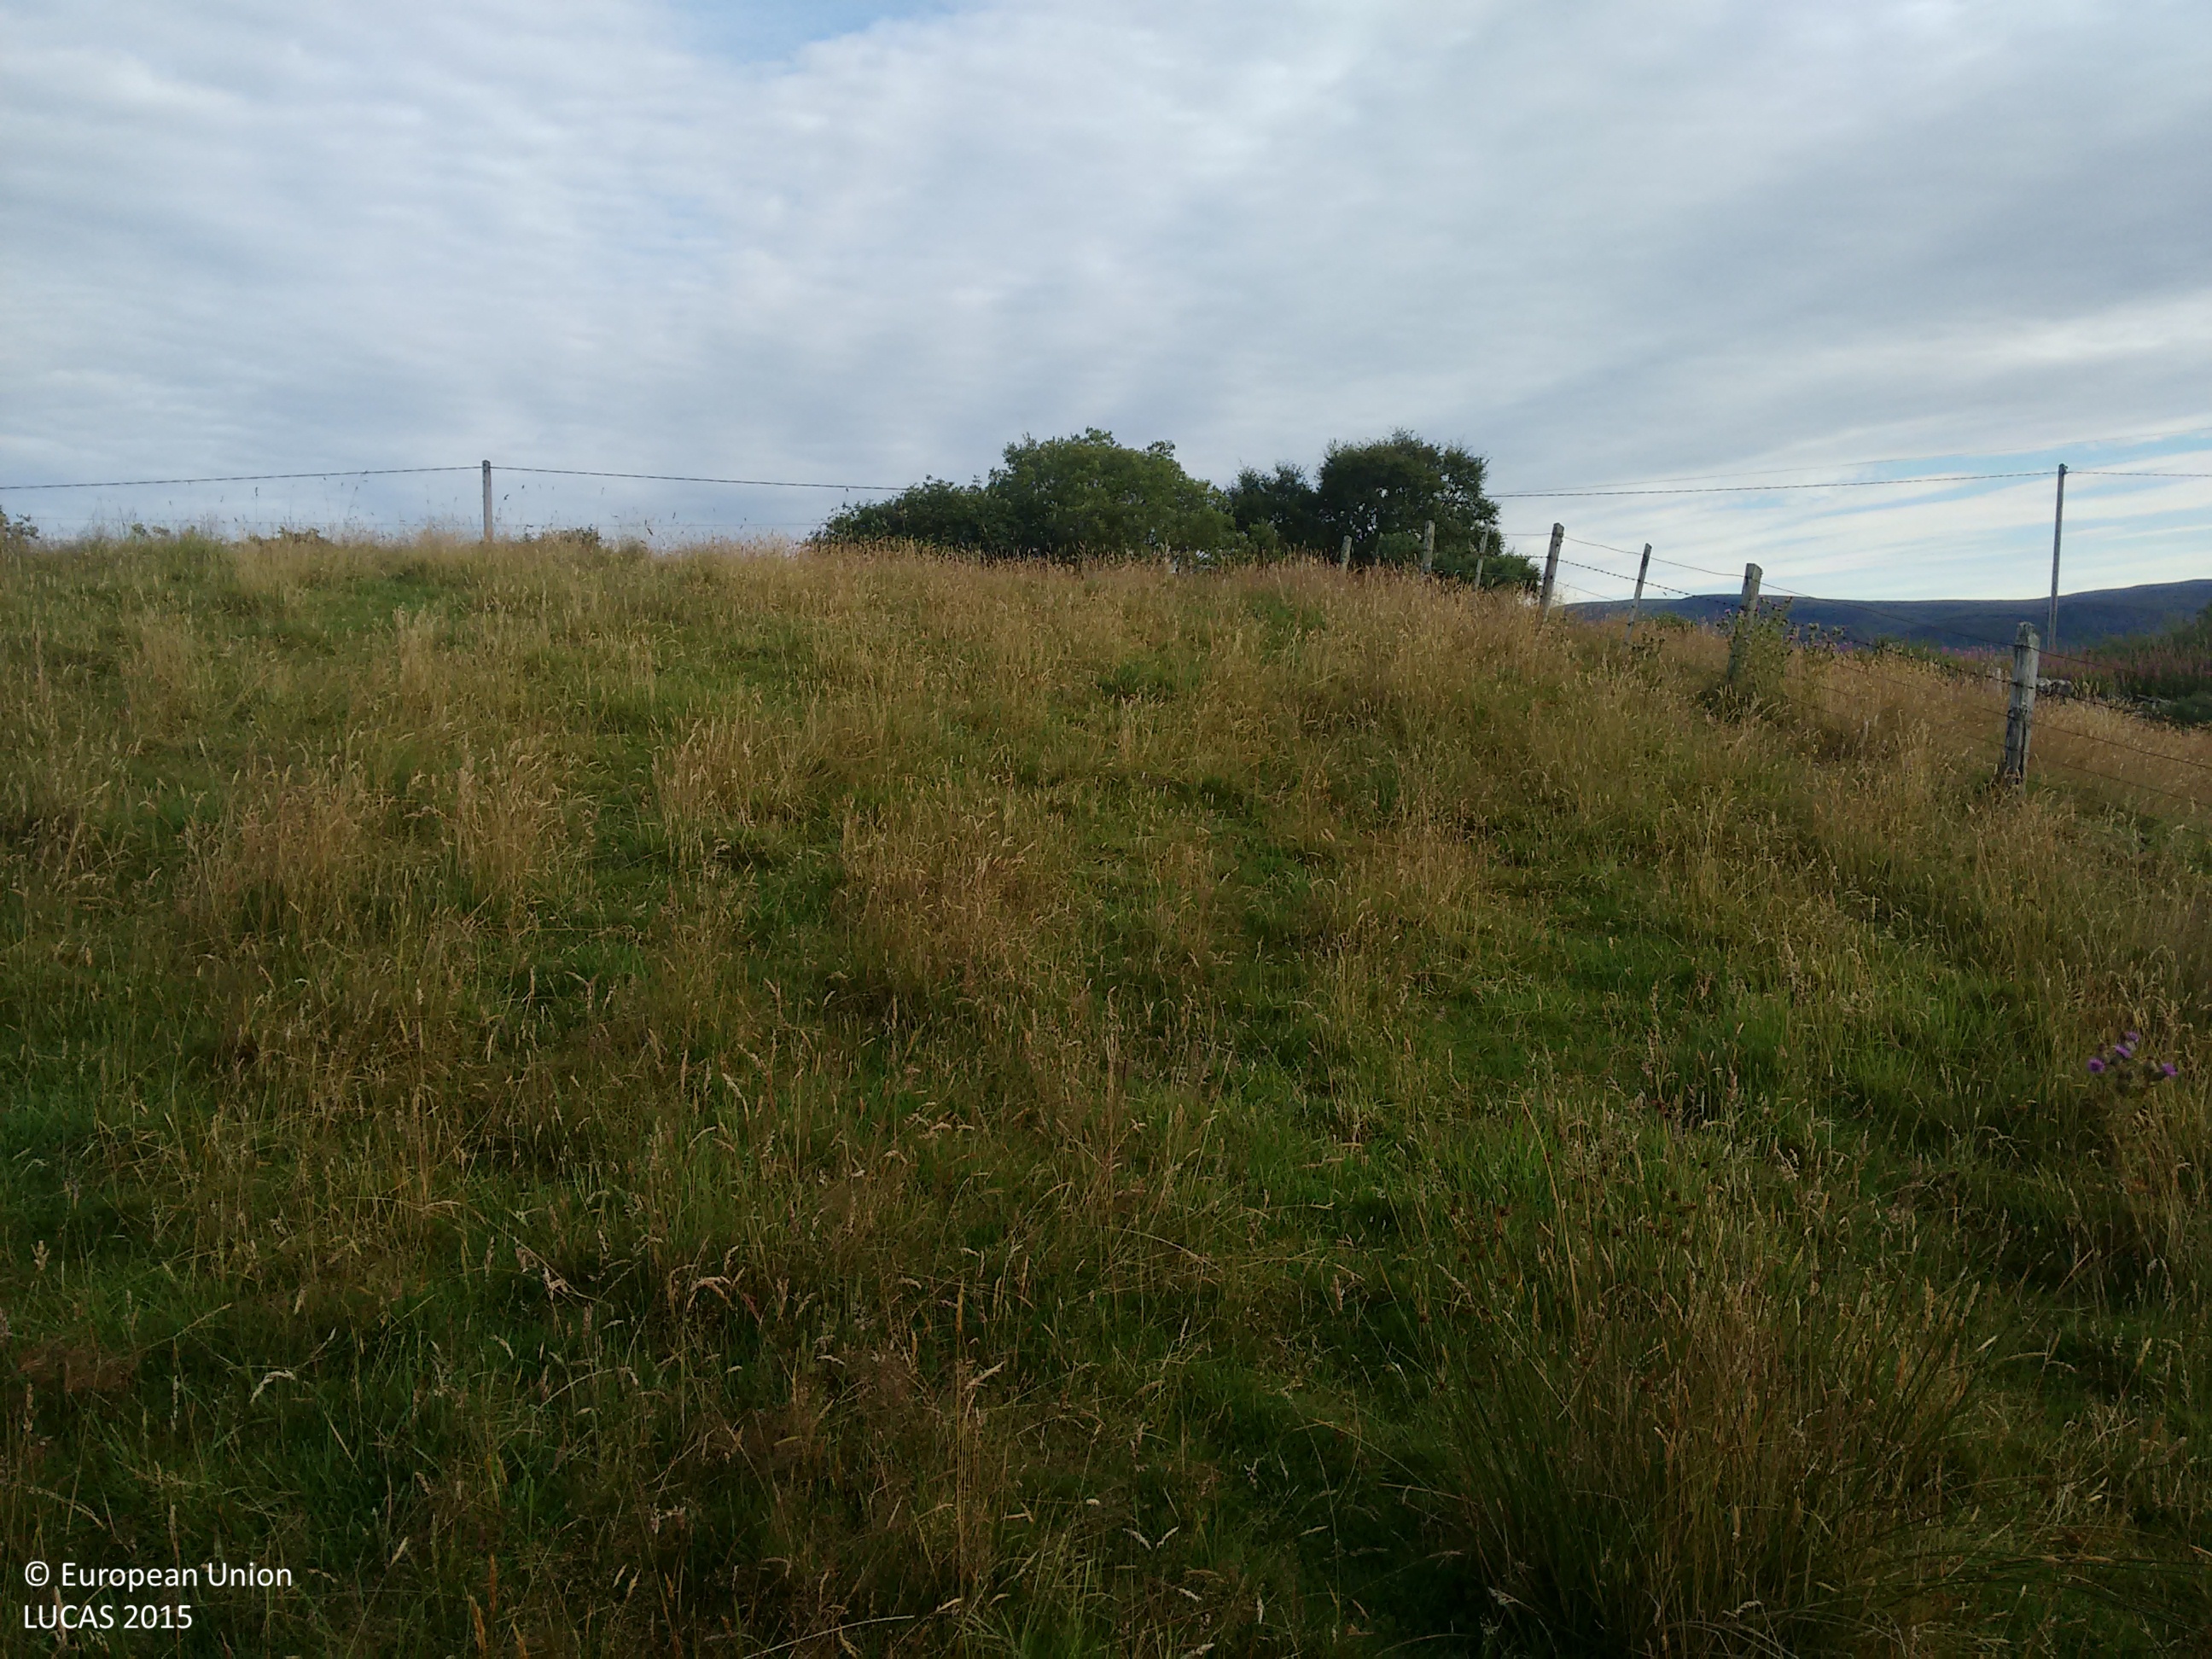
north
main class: Grassland
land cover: Grassland without tree/shrub cover
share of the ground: > 75 %
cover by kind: herbaceous plants 100 %
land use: Agriculture (excluding fallow land and kitchen gardens)
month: August
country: GB
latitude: 57.9308
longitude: -4.0786
